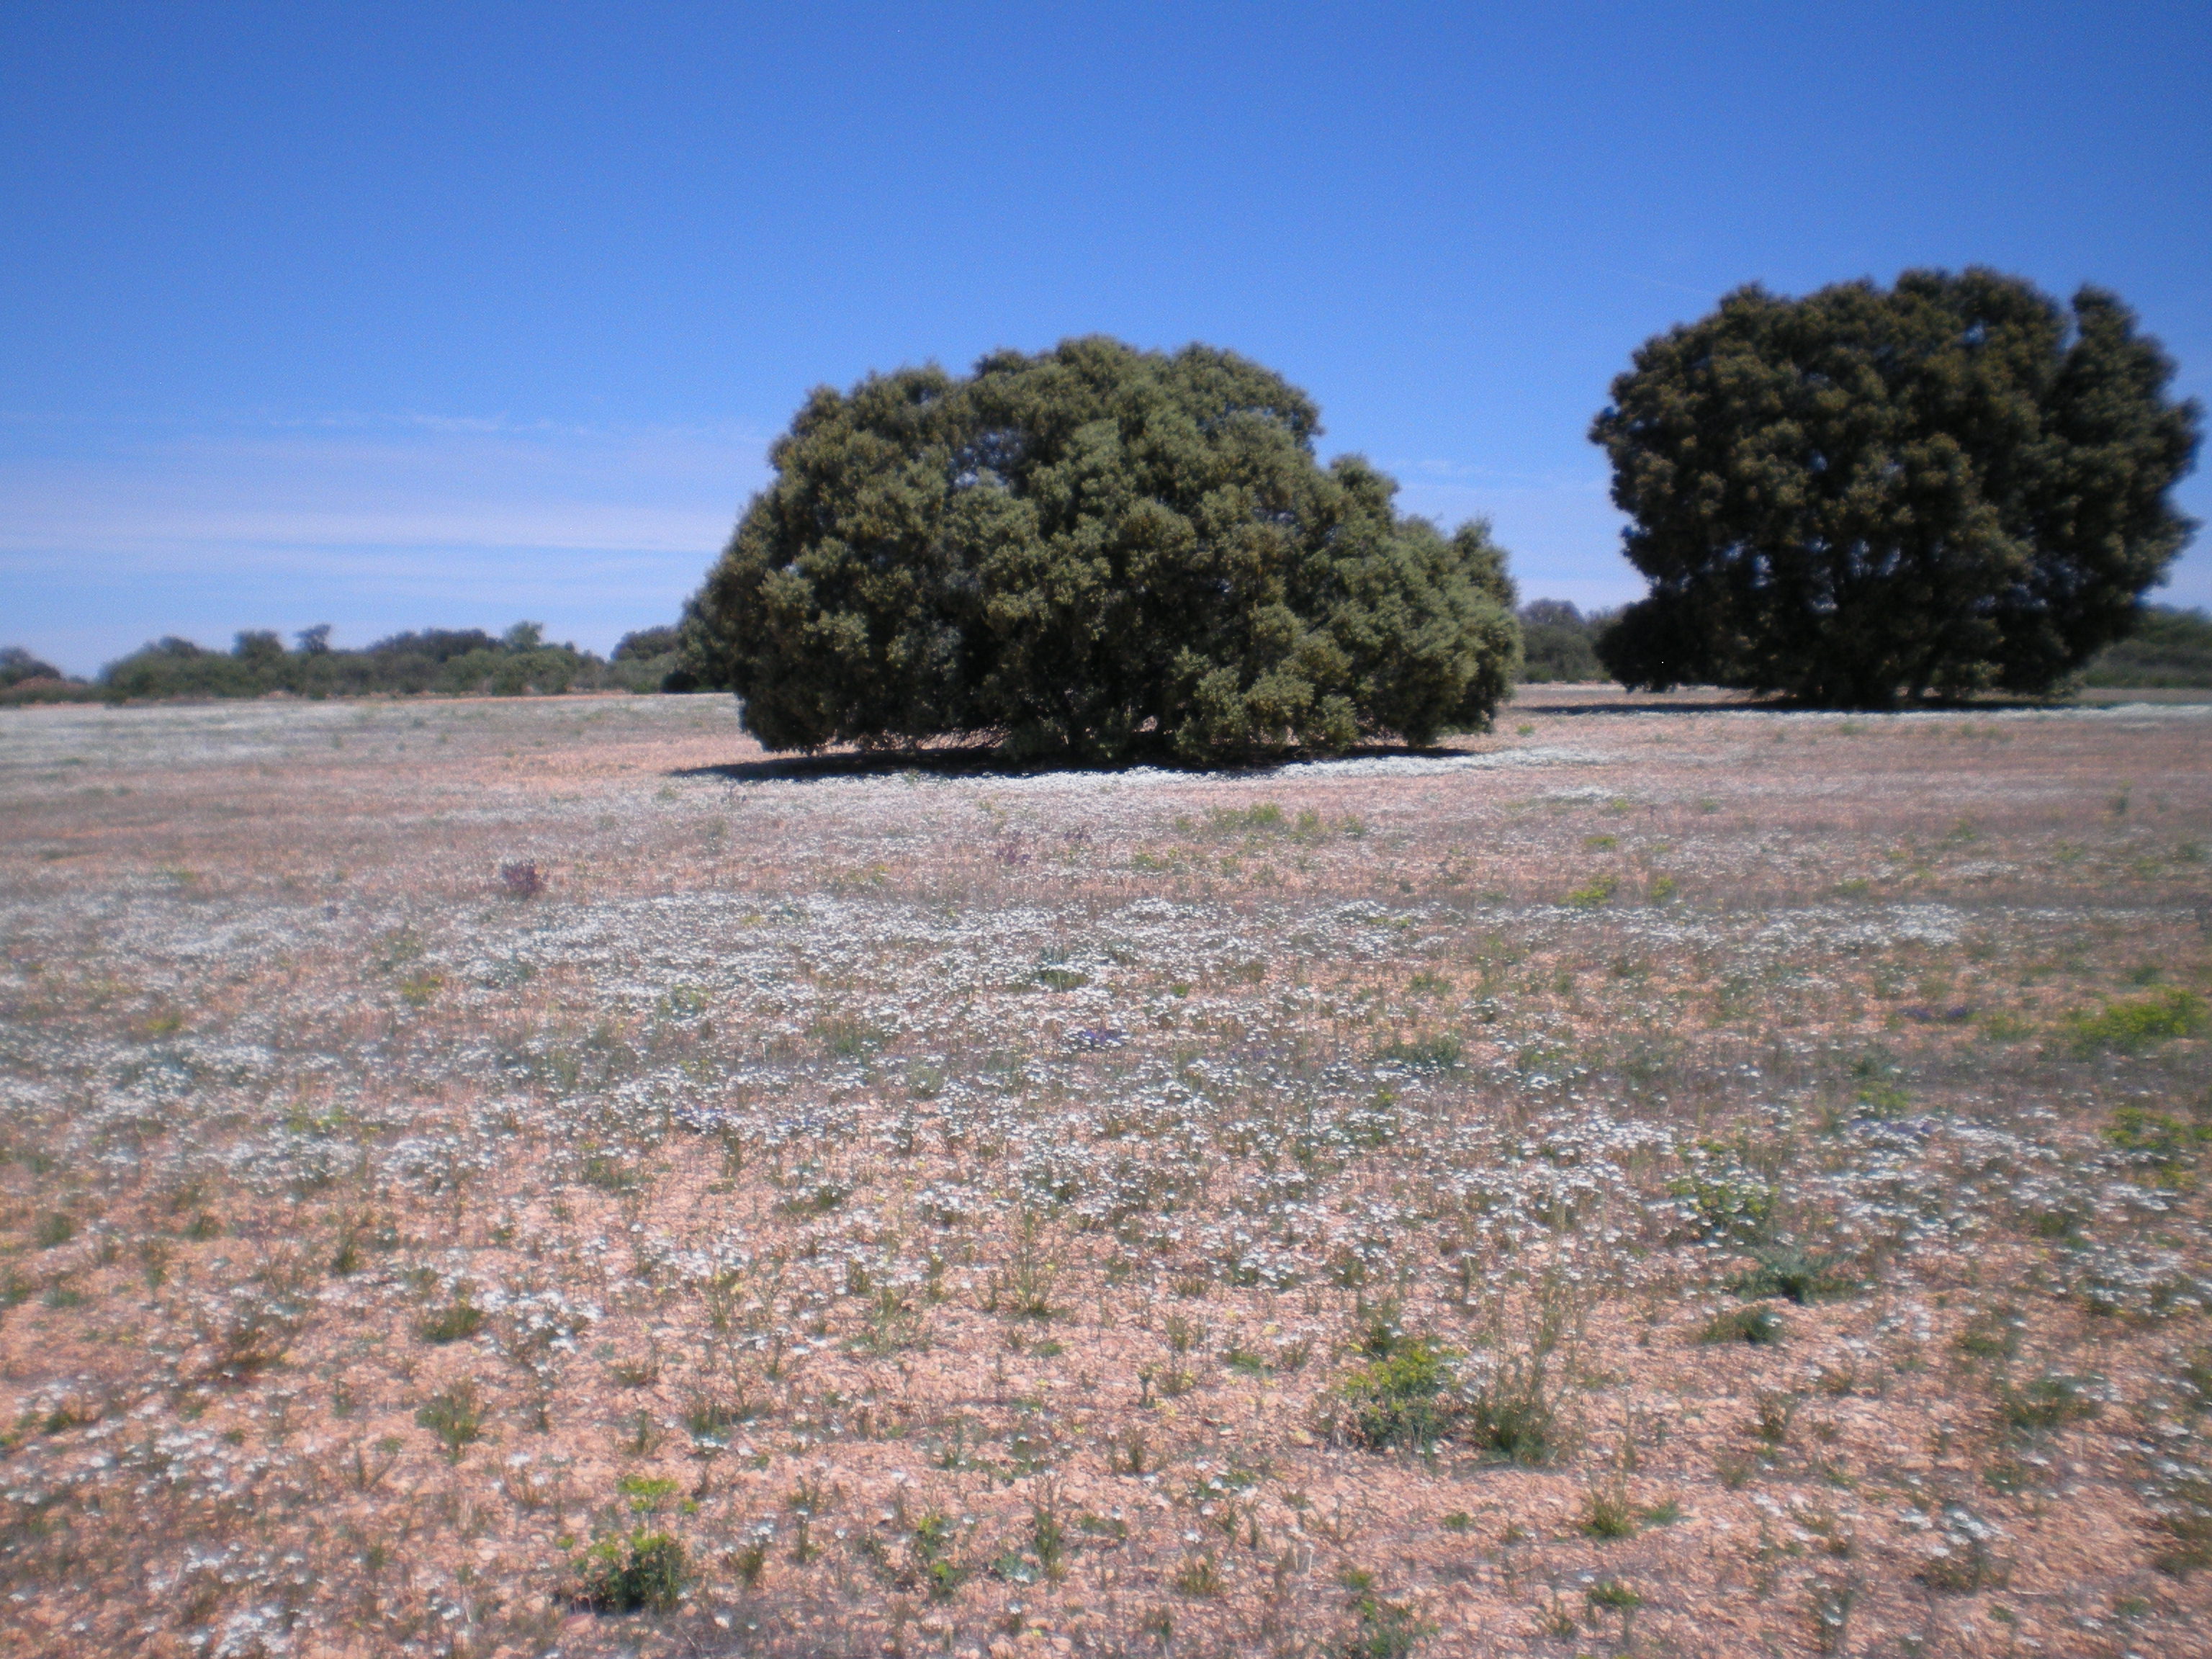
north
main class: Grassland
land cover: Spontaneously vegetated surfaces
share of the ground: > 75 %
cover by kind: unconsolidated bare surface 70 %, herbaceous plants 30 %
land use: Fallow land
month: May
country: ES
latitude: 38.9957
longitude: -2.9995
